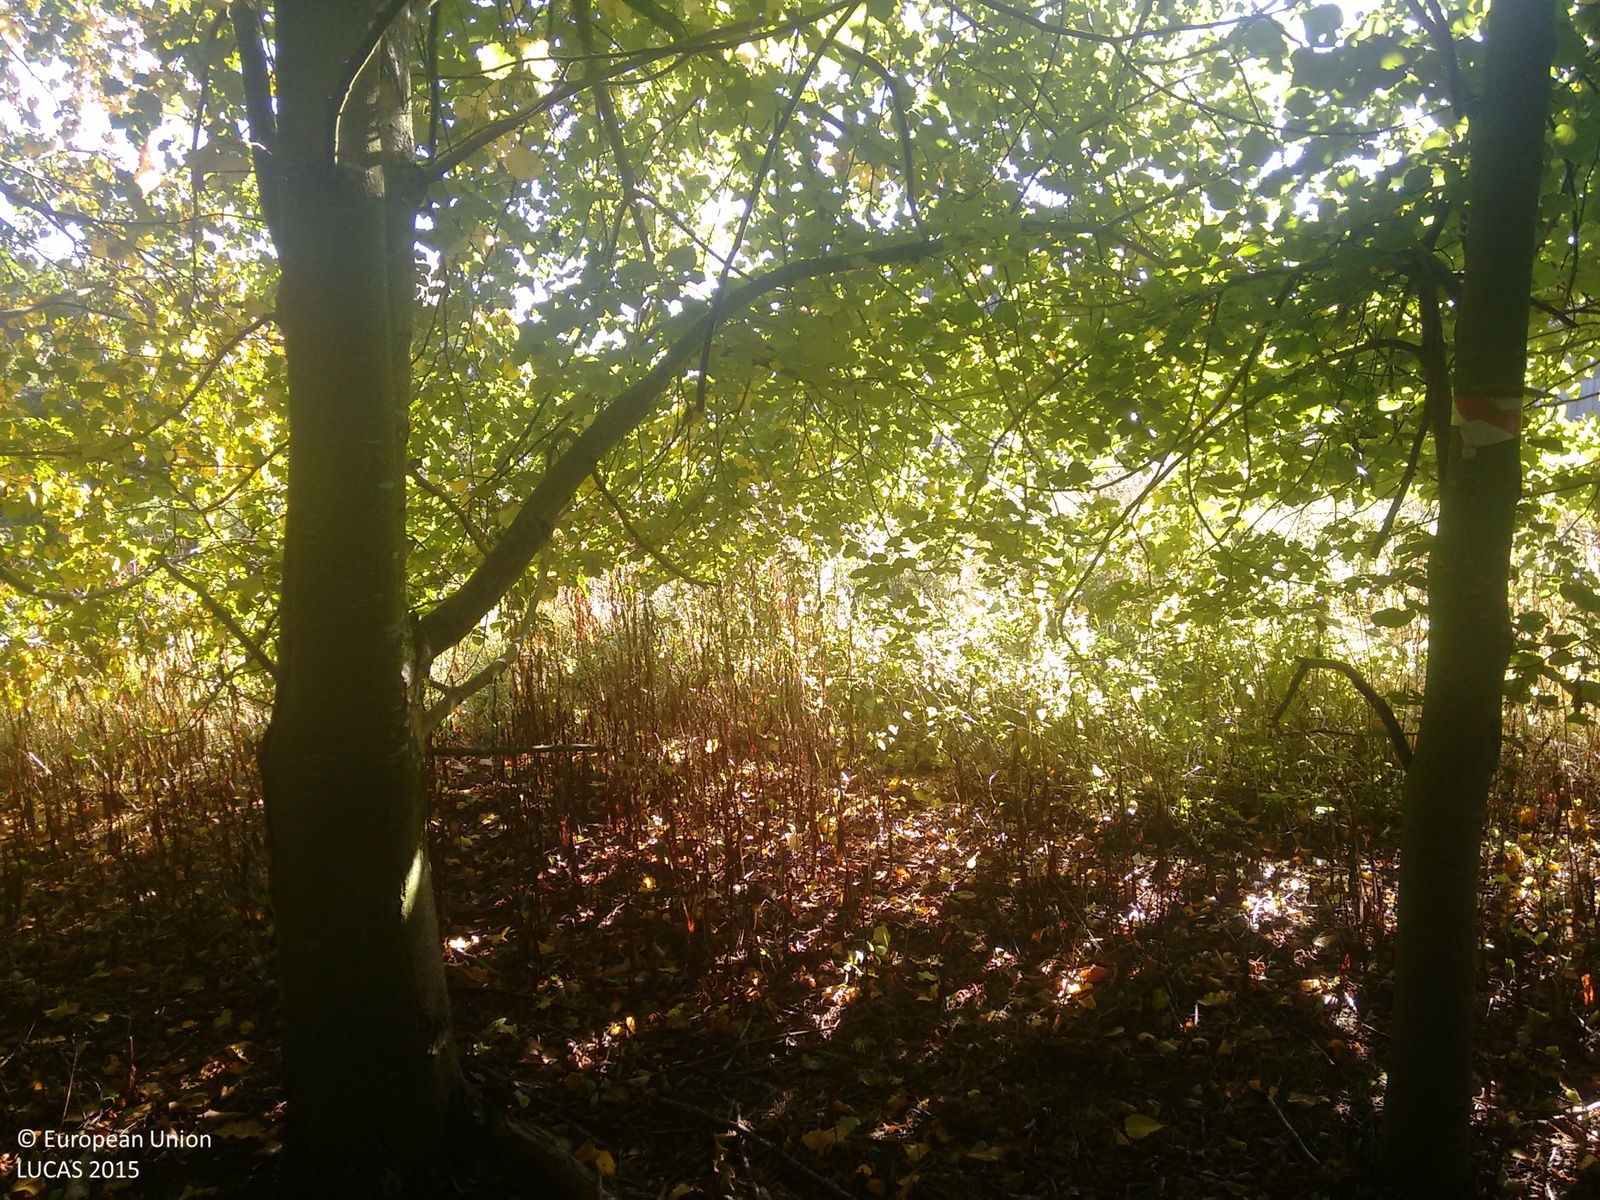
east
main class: Woodland
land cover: Broadleaved woodland
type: mesophytic deciduous forest
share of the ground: > 75 %
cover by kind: broadleaved forest trees 100 %
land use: Forestry
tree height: > 5 m
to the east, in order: Broadleaved woodland; Grassland with sparse tree/shrub cover; Artificial constructions in urban areas; Grassland with sparse tree/shrub cover; Managed hedges; Electric lines; Ditches and canals; Grass margins; Tracks; Grass margins; Other bare soil
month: September
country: GB
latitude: 52.2411
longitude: -0.0354
